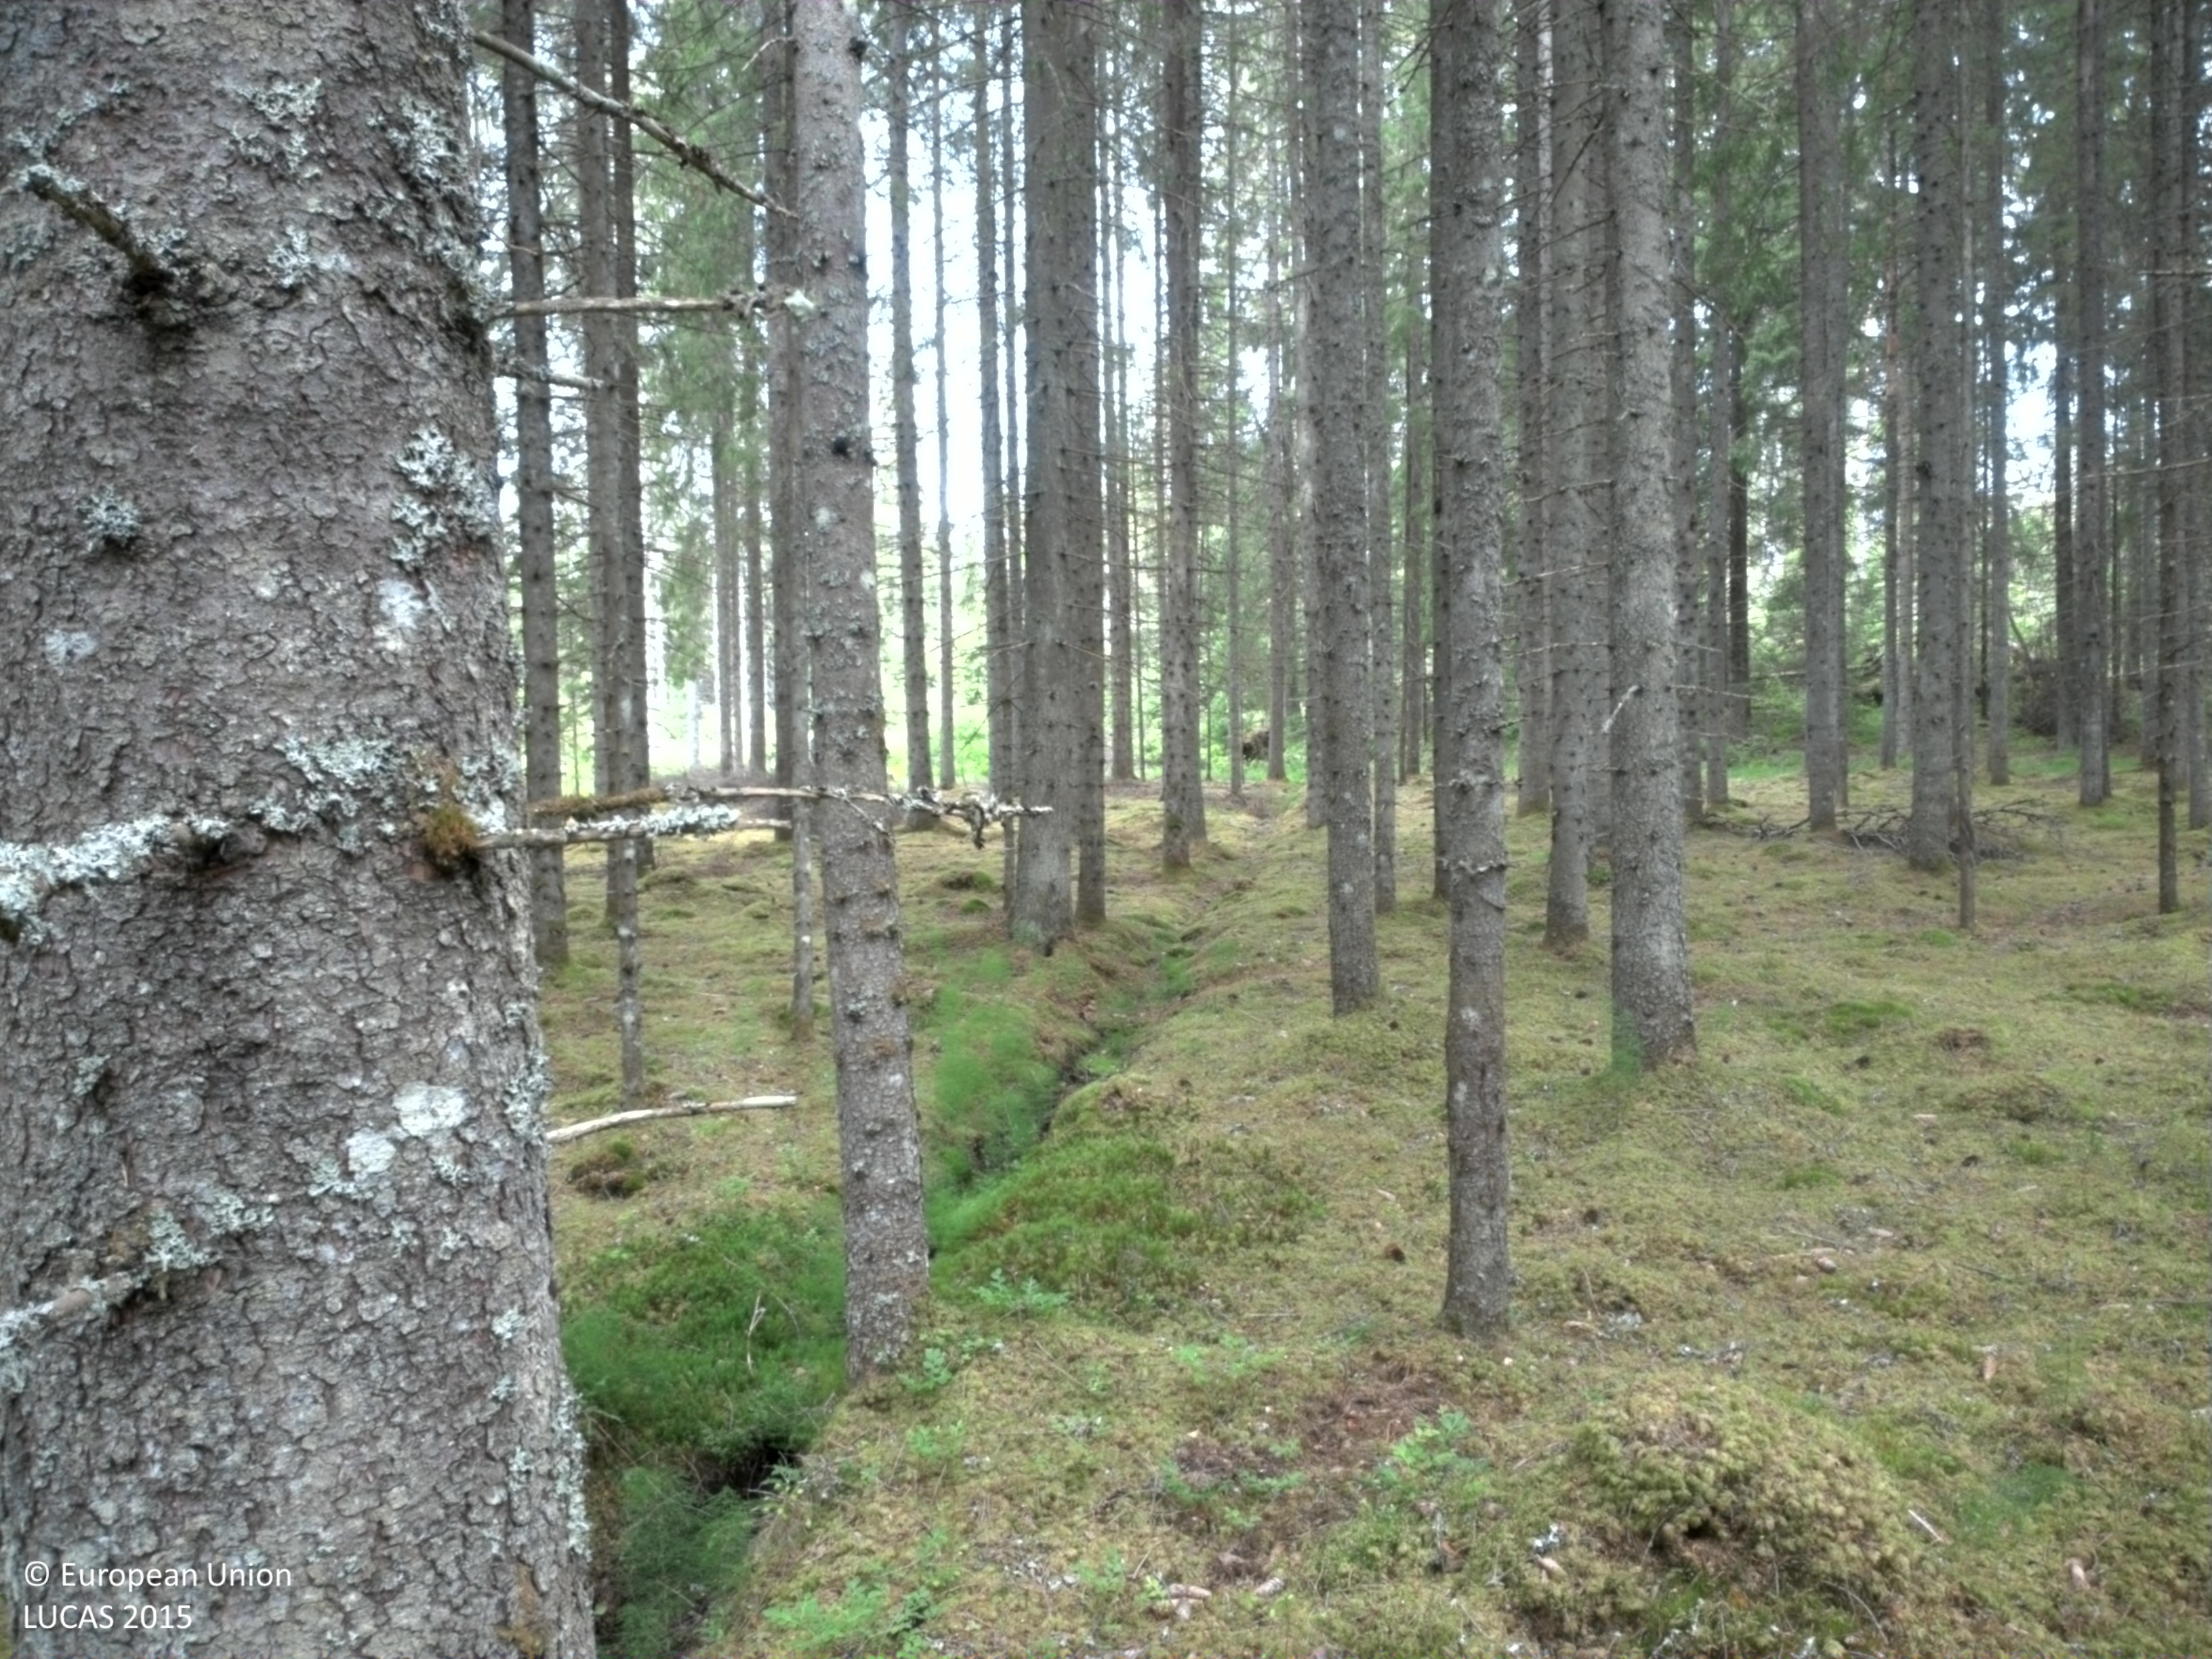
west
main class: Woodland
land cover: Spruce dominated coniferous woodland
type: boreal forest
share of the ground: 50 - 75 %
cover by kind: coniferous forest trees 45 %, lichens and mosses 35 %, broadleaved forest trees 15 %, shrubs 5 %
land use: Forestry
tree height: > 5 m
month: June
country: SE
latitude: 59.8372
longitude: 12.3309
